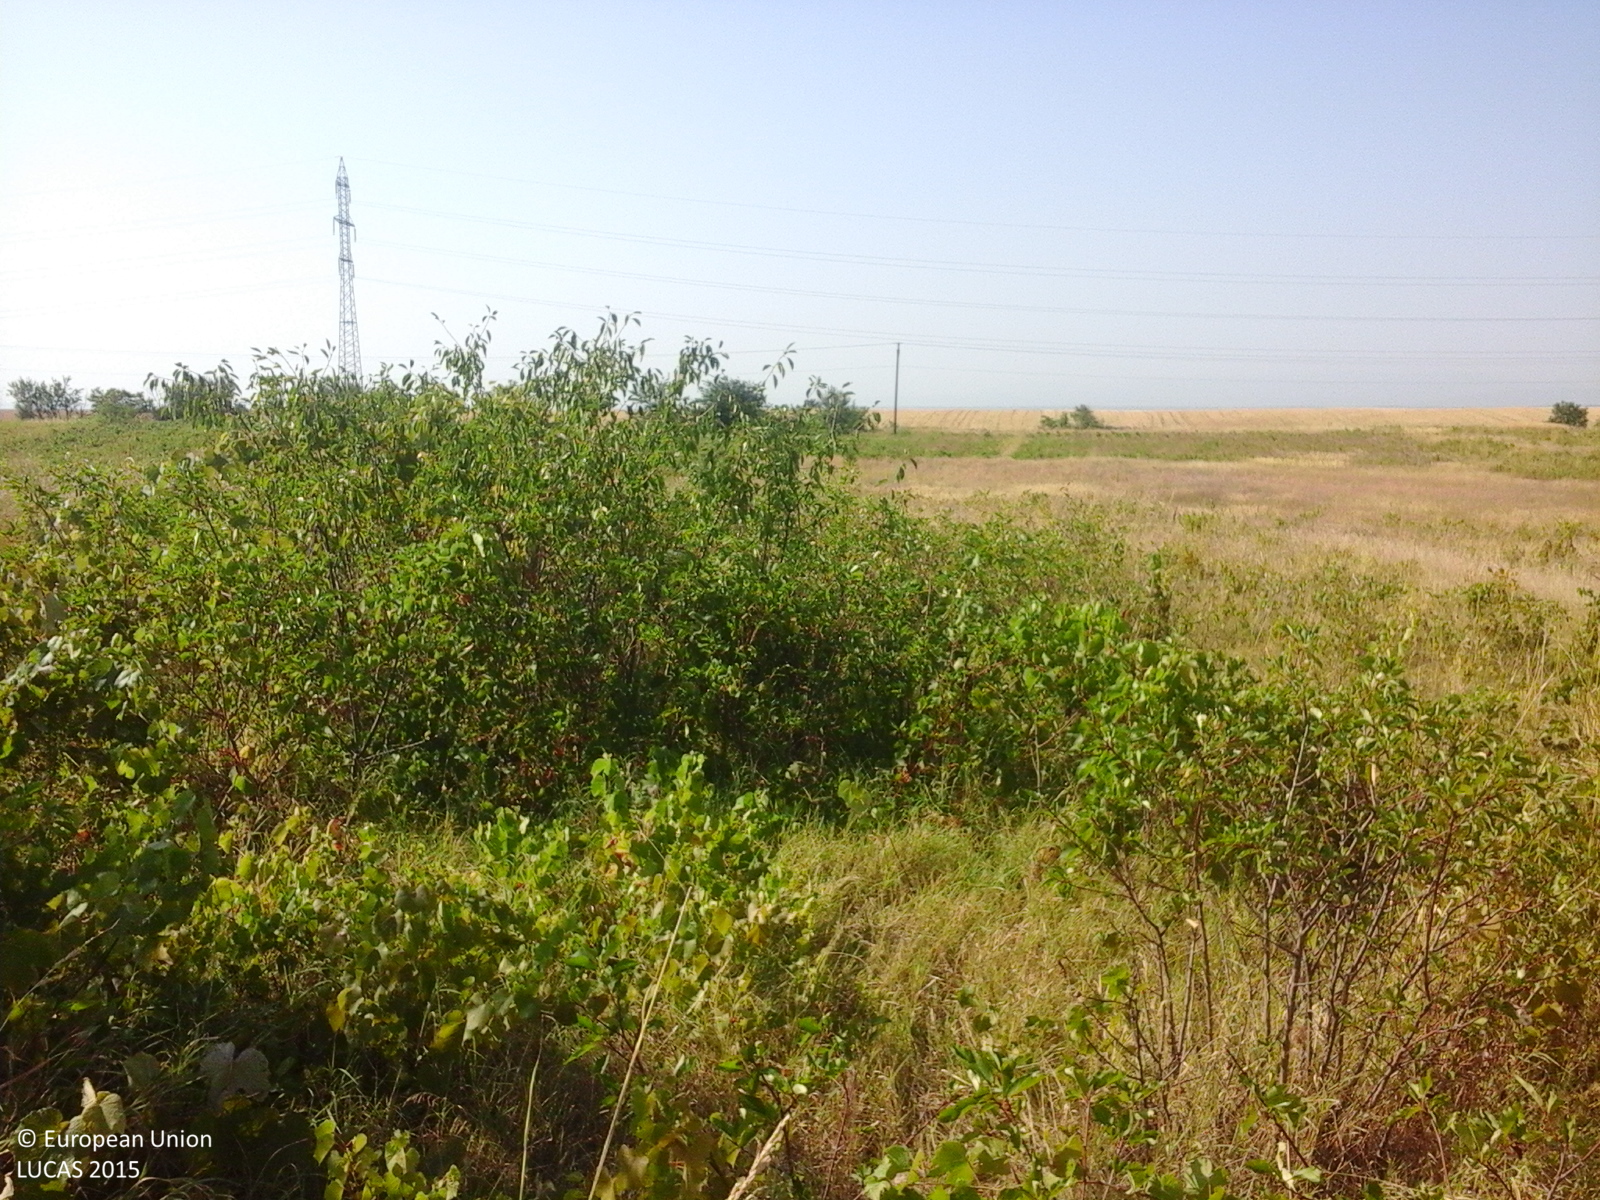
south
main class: Cropland
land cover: Vineyards
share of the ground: > 75 %
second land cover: Spontaneously vegetated surfaces
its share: > 75 %
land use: Agriculture (excluding fallow land and kitchen gardens)
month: August
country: RO
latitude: 43.9742
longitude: 22.9422
